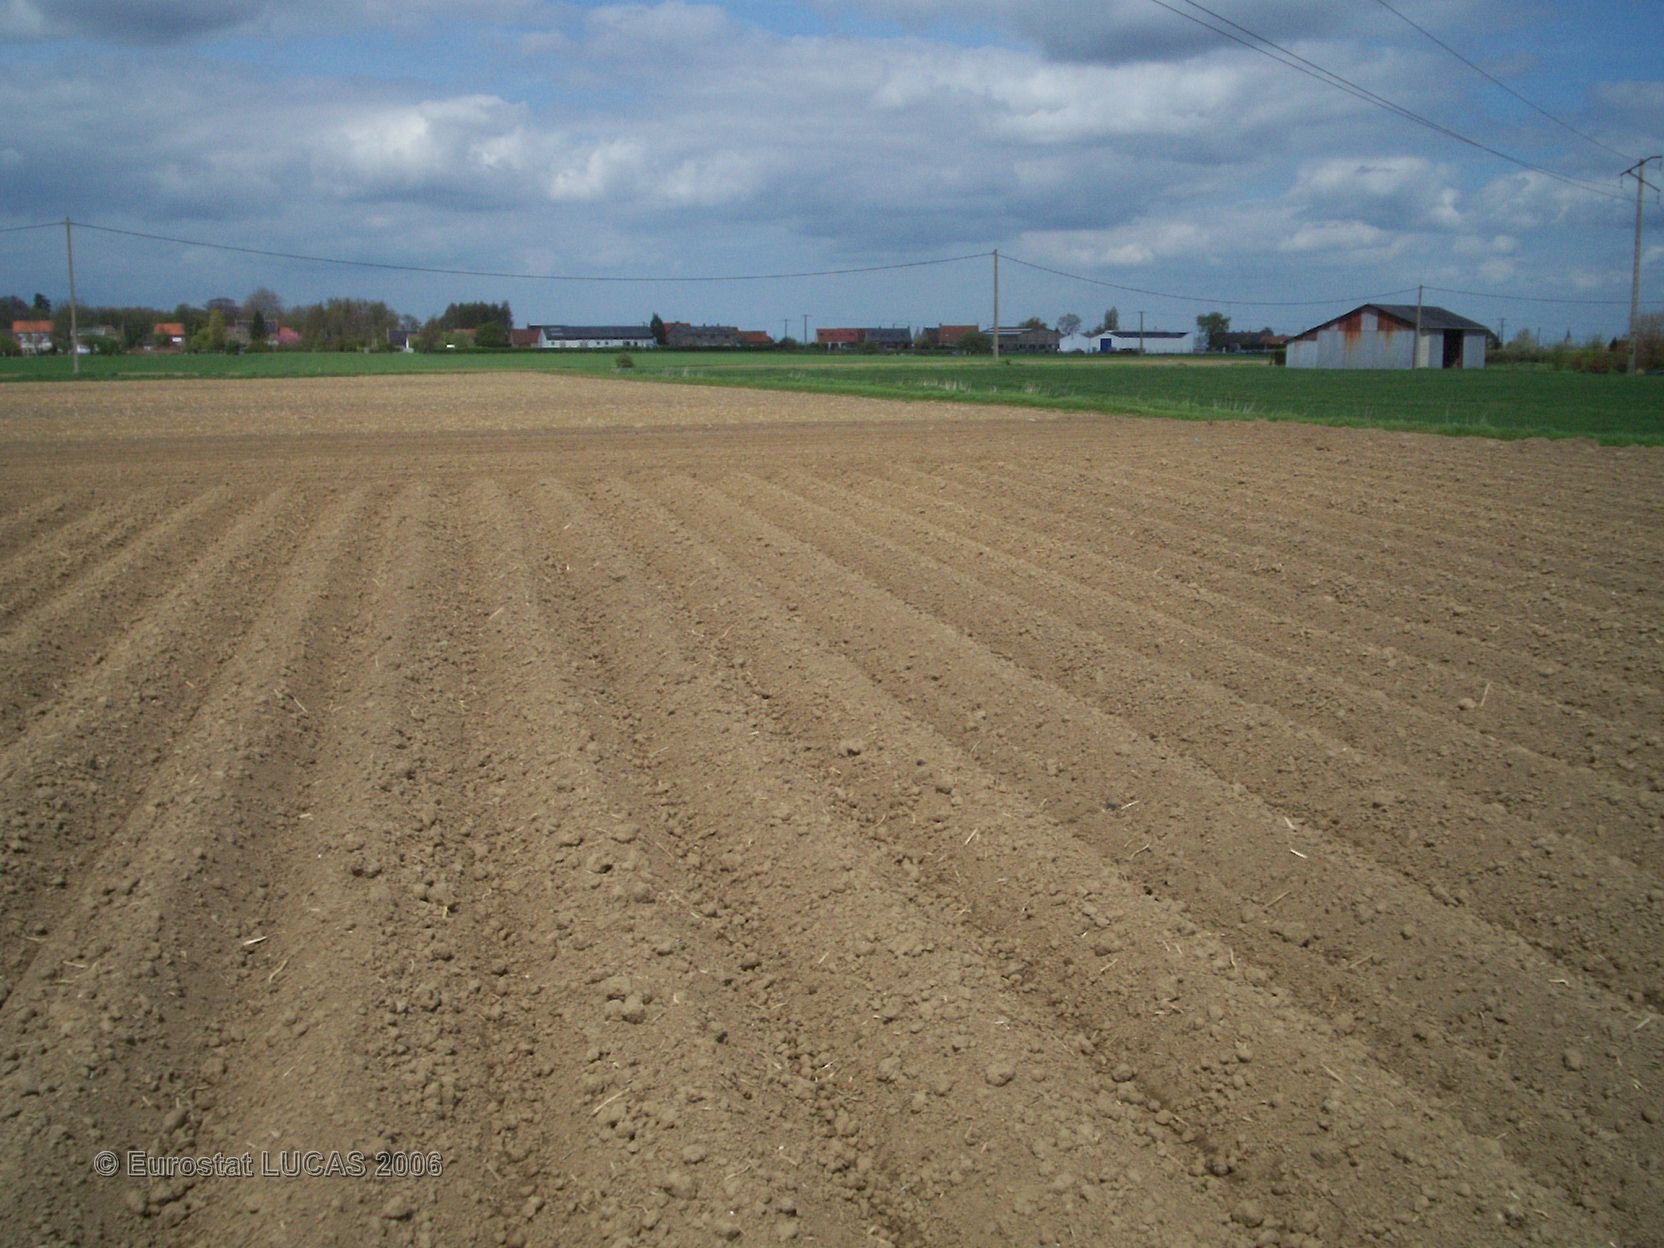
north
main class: Cropland
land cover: Potatoes
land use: Agriculture (excluding fallow land and kitchen gardens)
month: May
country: FR
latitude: 50.9333
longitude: 2.5456
